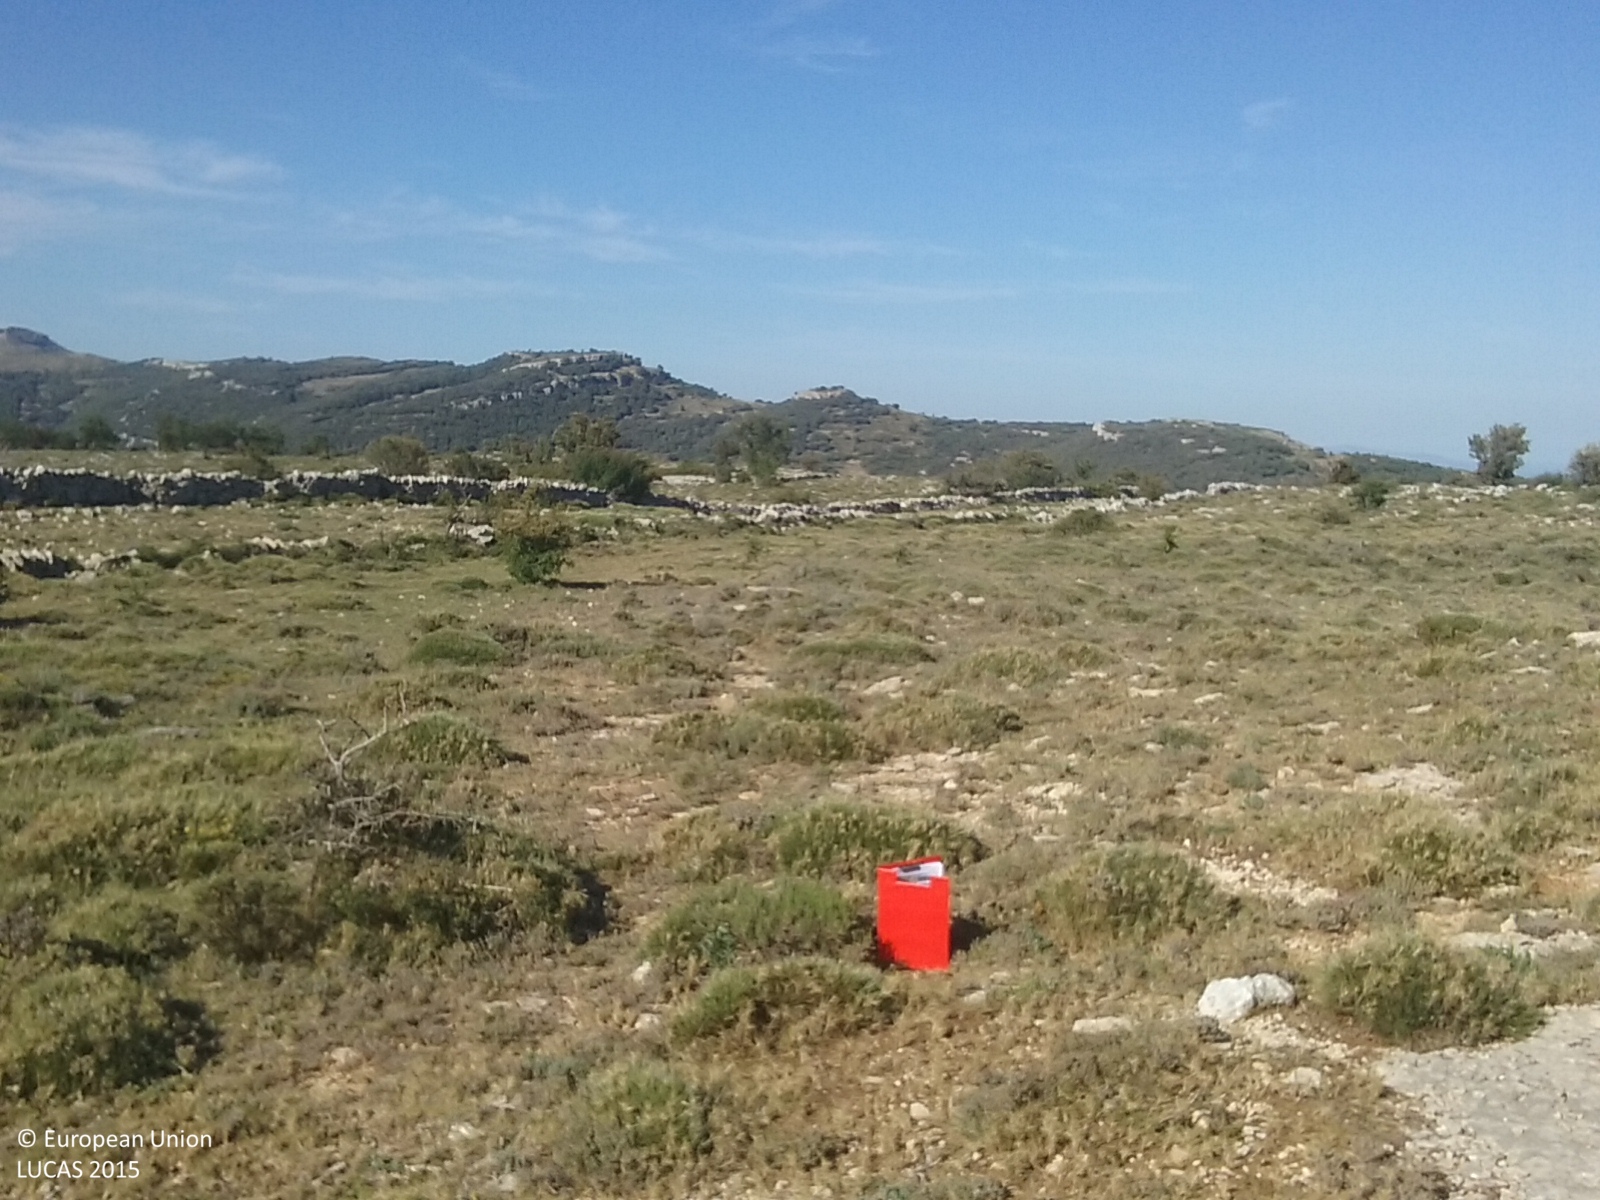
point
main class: Shrubland
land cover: Shrubland without tree cover
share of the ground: > 75 %
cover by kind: herbaceous plants 60 %, shrubs 30 %
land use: Agriculture (excluding fallow land and kitchen gardens)
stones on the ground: 25 - 50 %
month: May
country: ES
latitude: 40.4231
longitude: -0.0590
